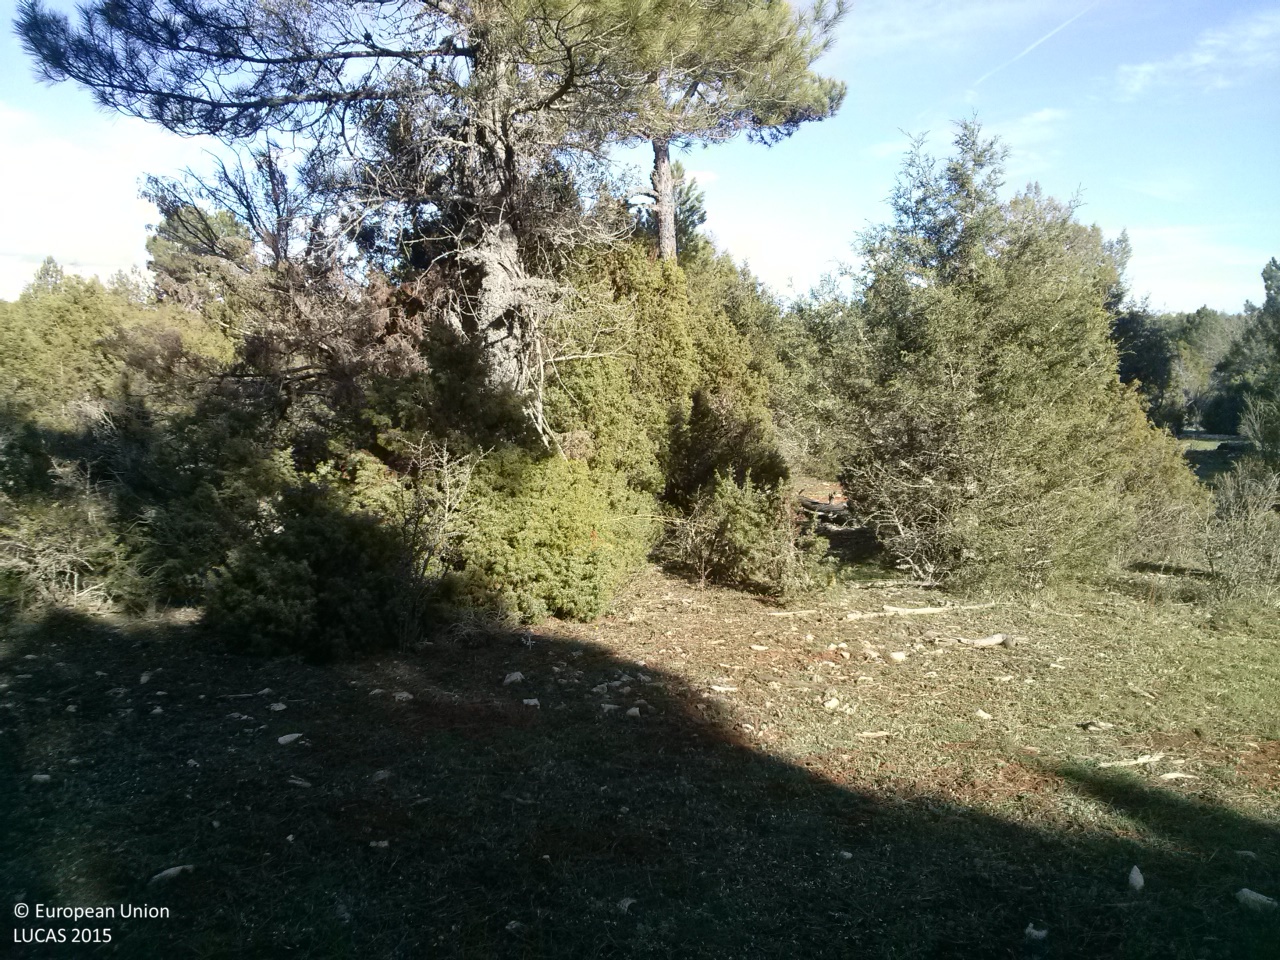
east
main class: Woodland
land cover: Other coniferous woodland
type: coniferous forest of the mediterranean region
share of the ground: 25 - 50 %
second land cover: Grassland without tree/shrub cover
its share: 50 - 75 %
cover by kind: herbaceous plants 60 %, coniferous forest trees 35 %, shrubs 5 %
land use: Forestry
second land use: Agriculture (excluding fallow land and kitchen gardens)
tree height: > 5 m
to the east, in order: Other coniferous woodland; Grassland without tree/shrub cover; Other coniferous woodland; Tracks; Other coniferous woodland; Tracks; Other coniferous woodland
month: April
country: ES
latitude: 40.1482
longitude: -1.8586
